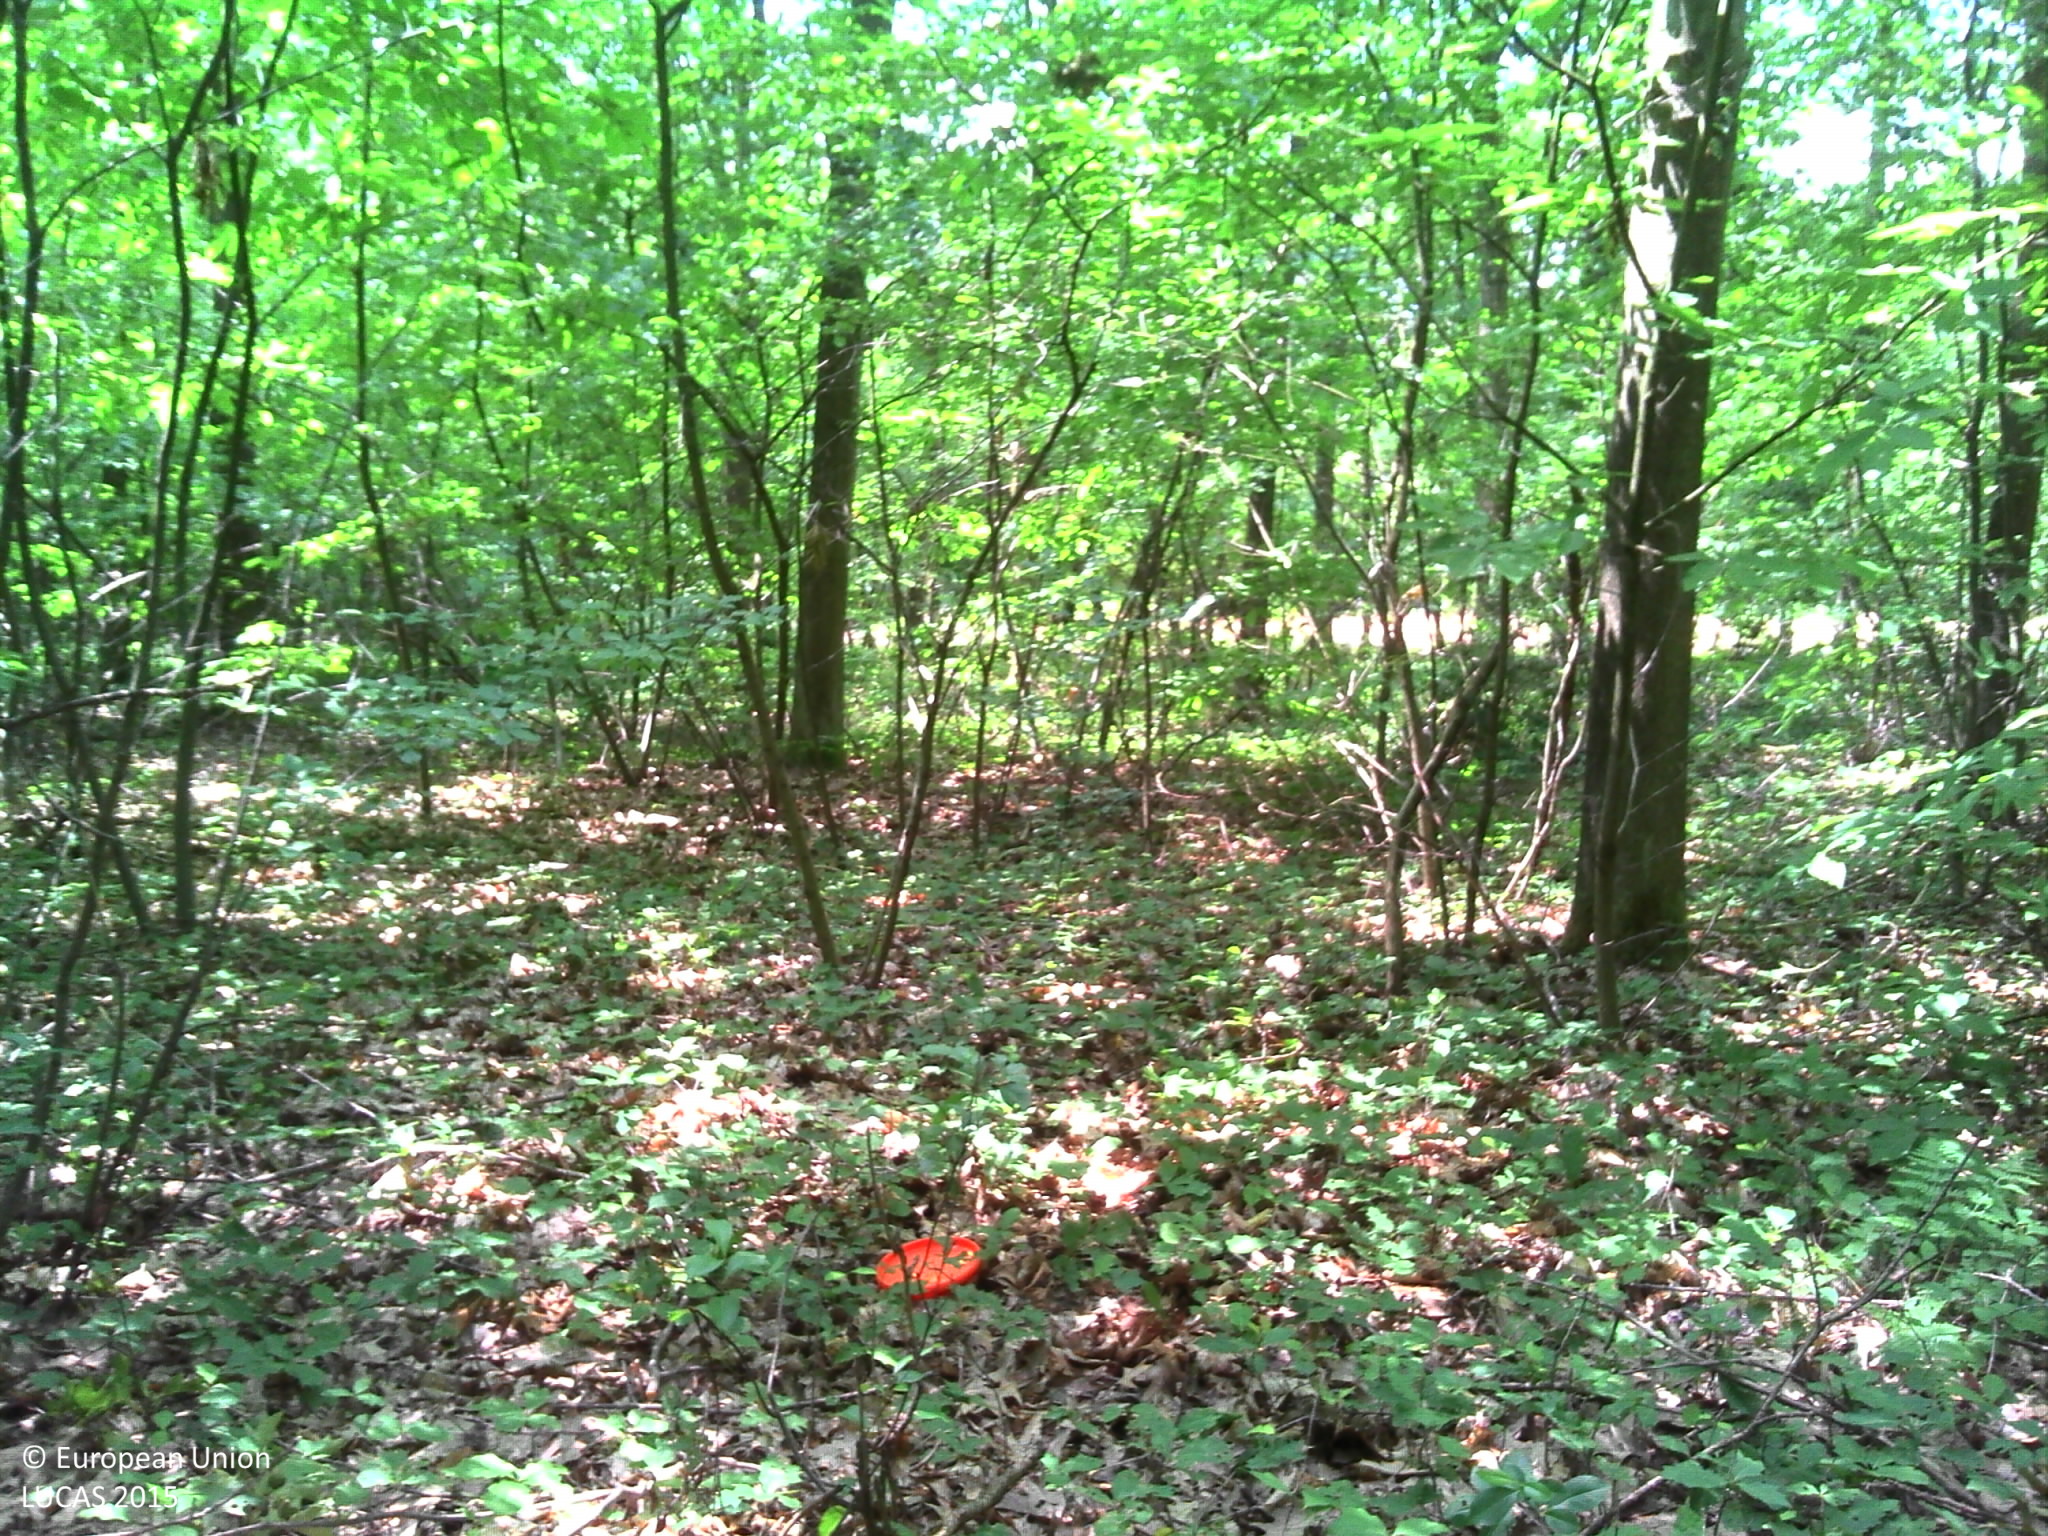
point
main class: Woodland
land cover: Broadleaved woodland
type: acidophilous oak and oak-birch forest
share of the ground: > 75 %
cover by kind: broadleaved forest trees 100 %
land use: Forestry
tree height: > 5 m
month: May
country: BE
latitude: 50.7397
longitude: 4.5687
